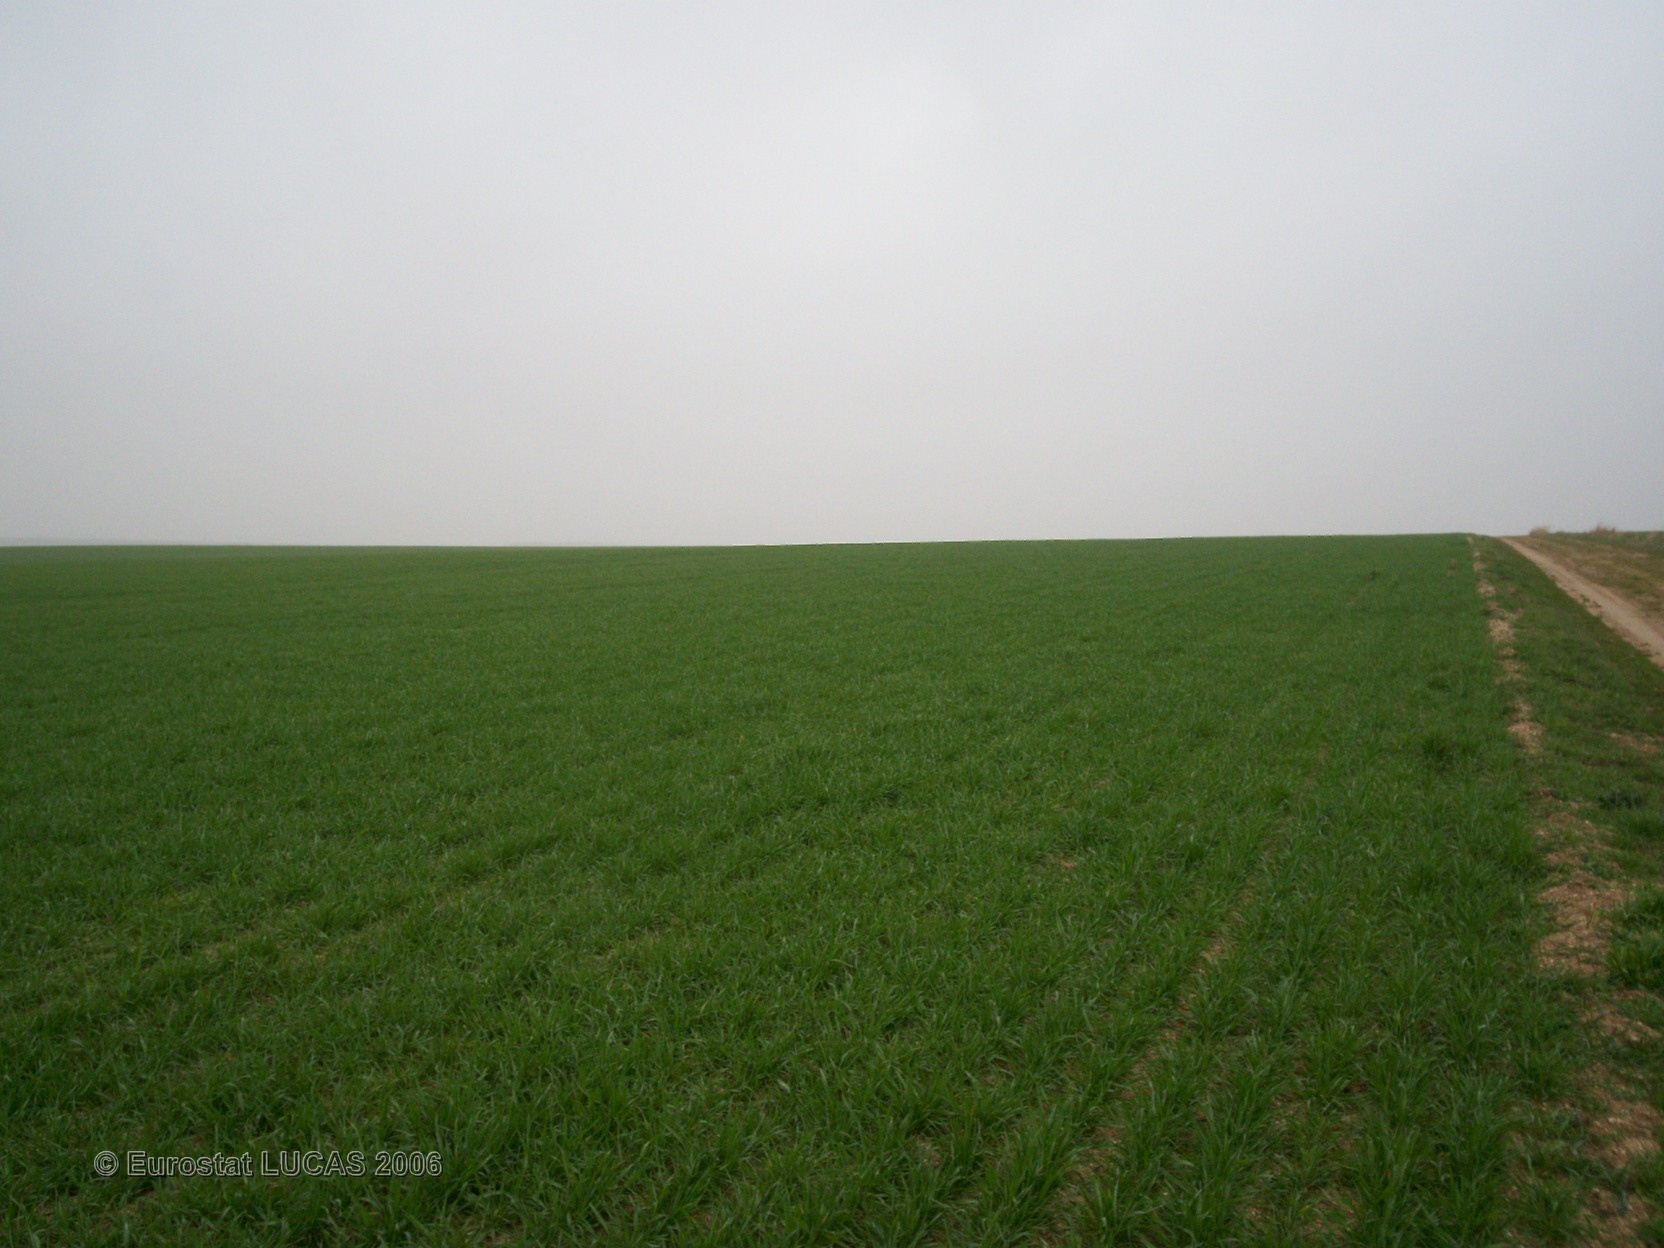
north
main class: Cropland
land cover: Common wheat
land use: Agriculture (excluding fallow land and kitchen gardens)
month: April
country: FR
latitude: 49.2564
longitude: 4.4592
